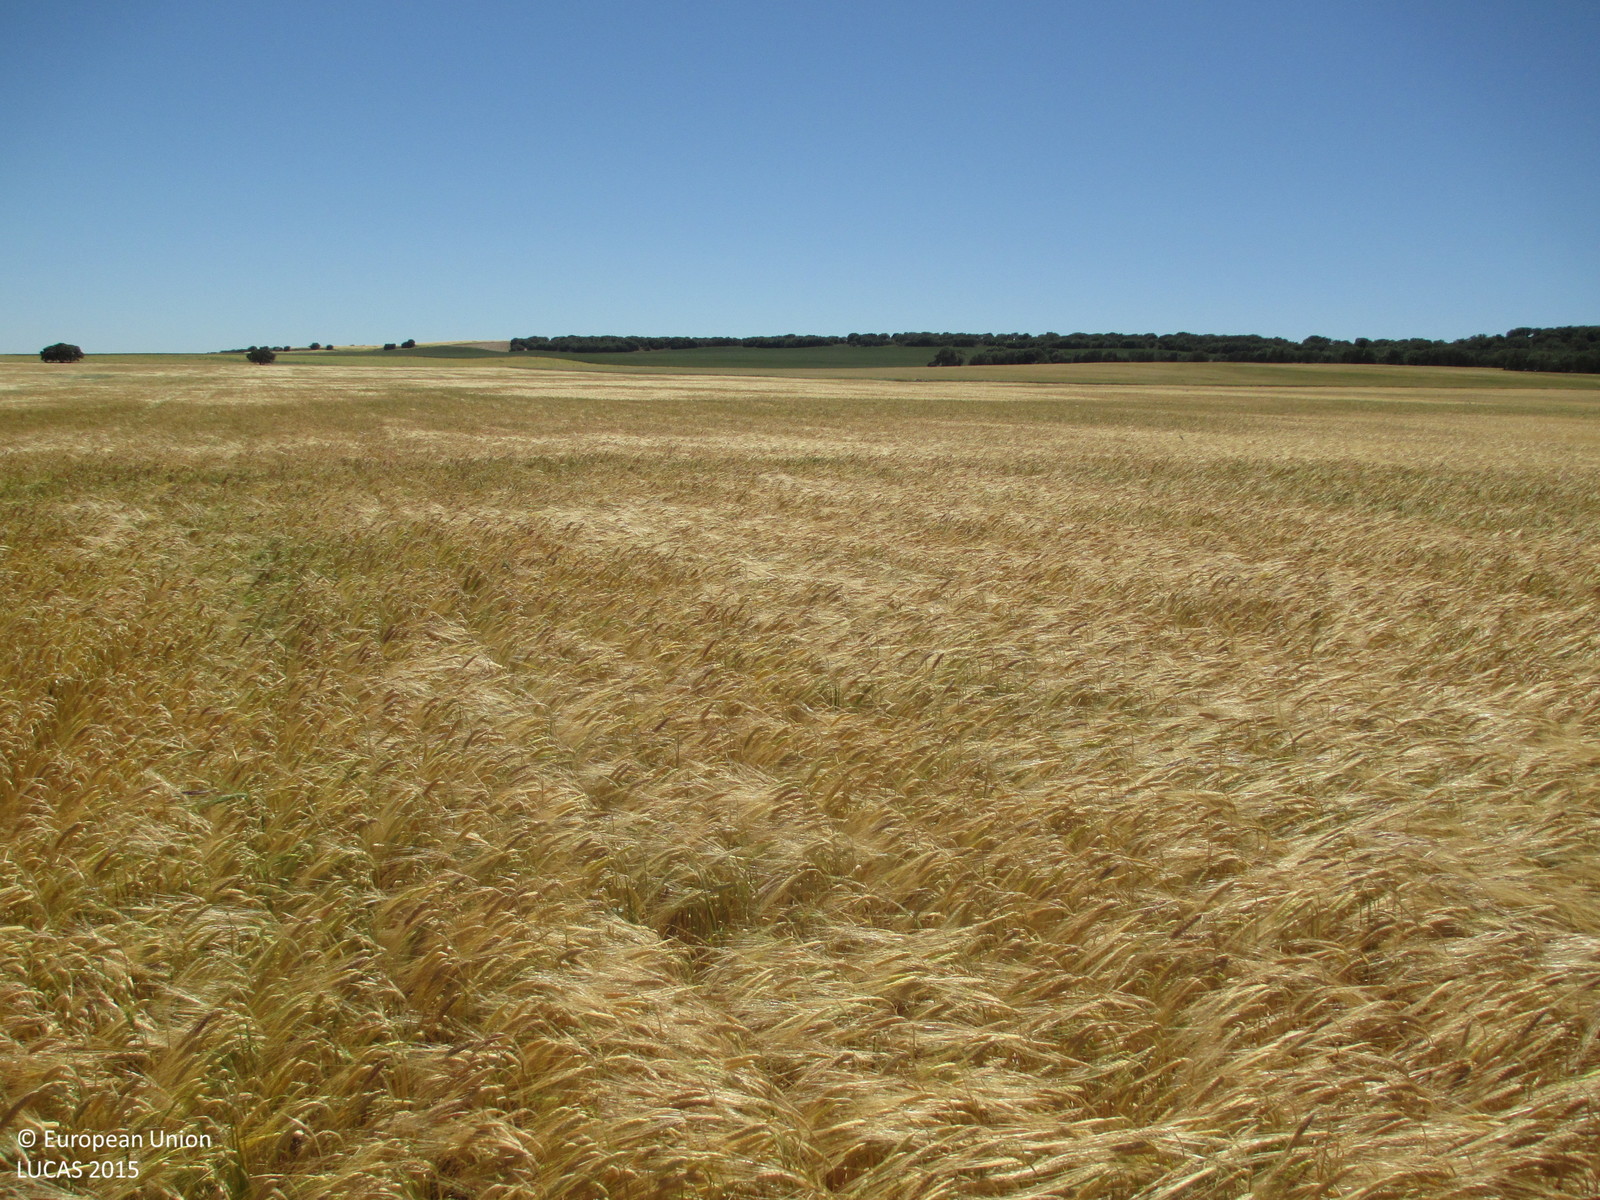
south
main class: Cropland
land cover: Barley
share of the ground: > 75 %
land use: Agriculture (excluding fallow land and kitchen gardens)
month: May
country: ES
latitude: 41.9951
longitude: -0.1722
